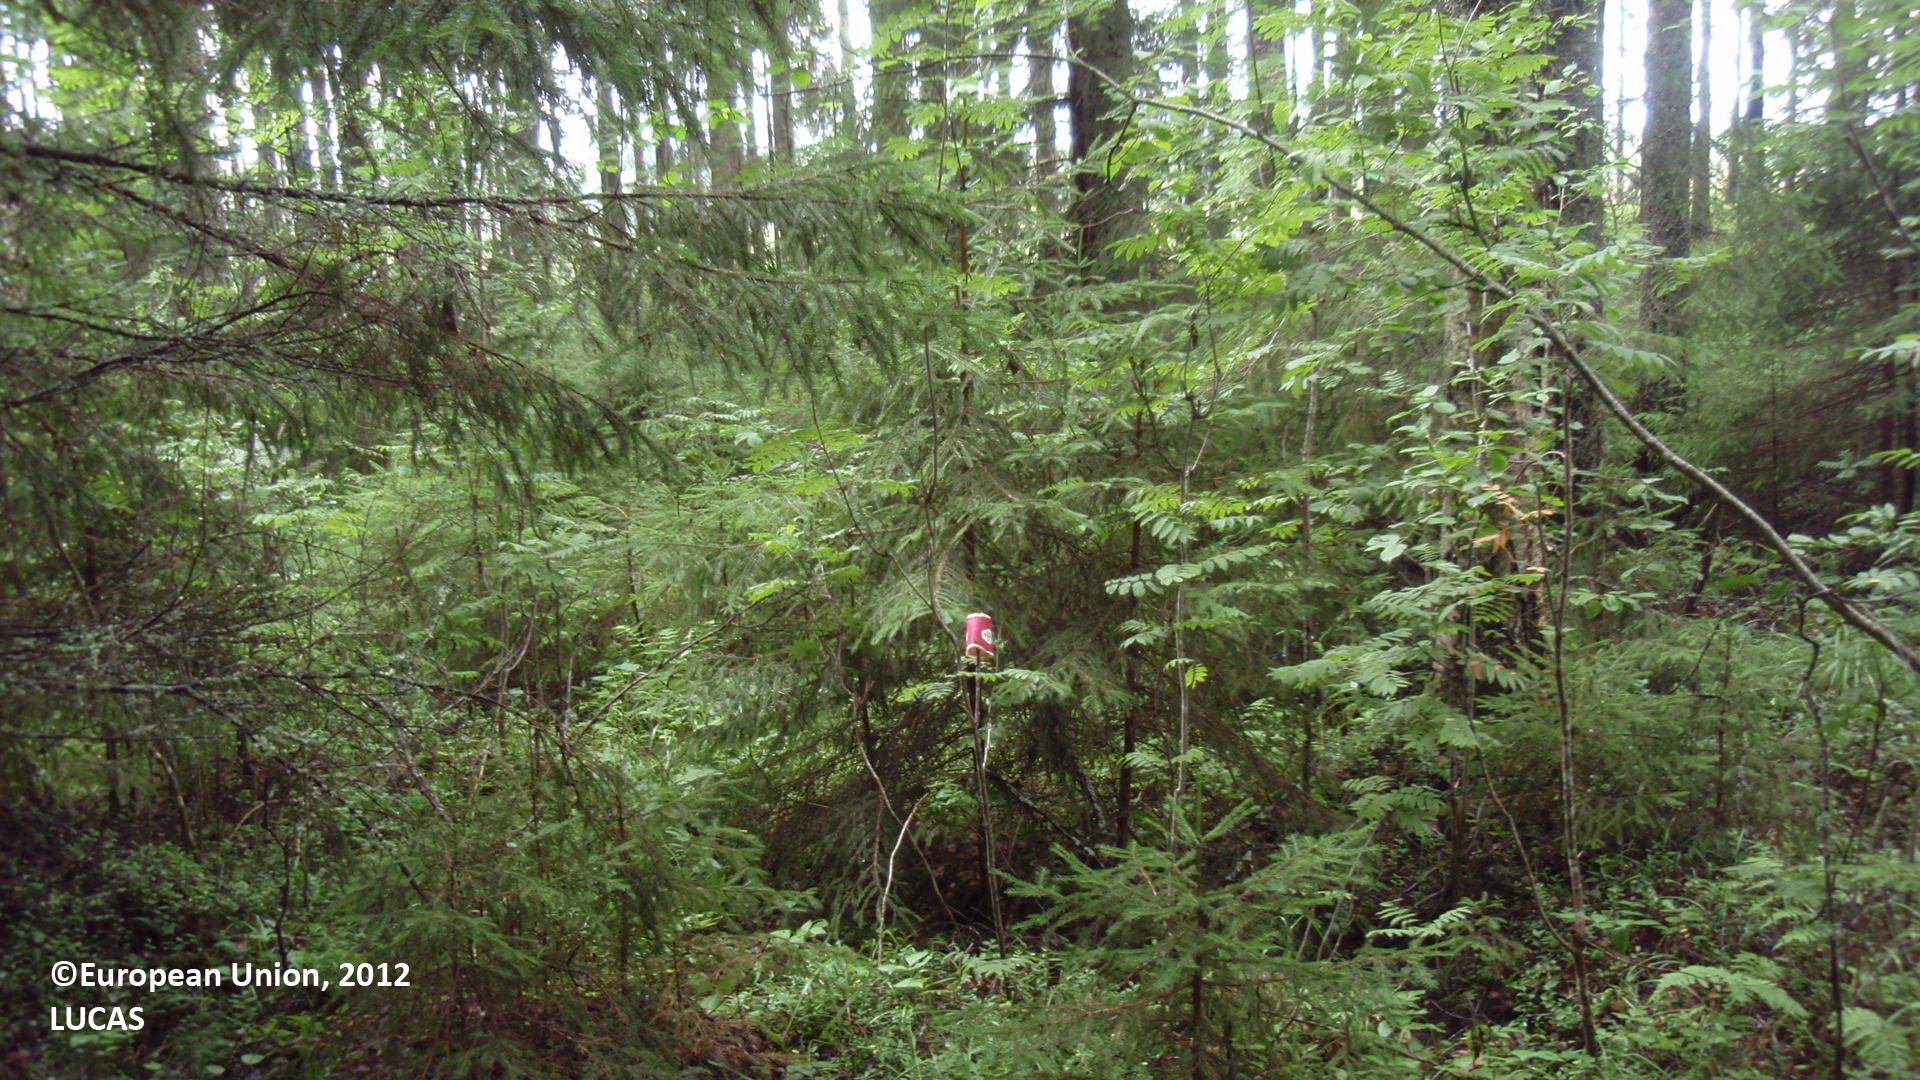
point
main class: Woodland
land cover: Pine dominated mixed woodland
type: boreal forest
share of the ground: 50 - 75 %
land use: Forestry
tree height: > 5 m
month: July
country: FI
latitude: 61.5545
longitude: 26.8888
